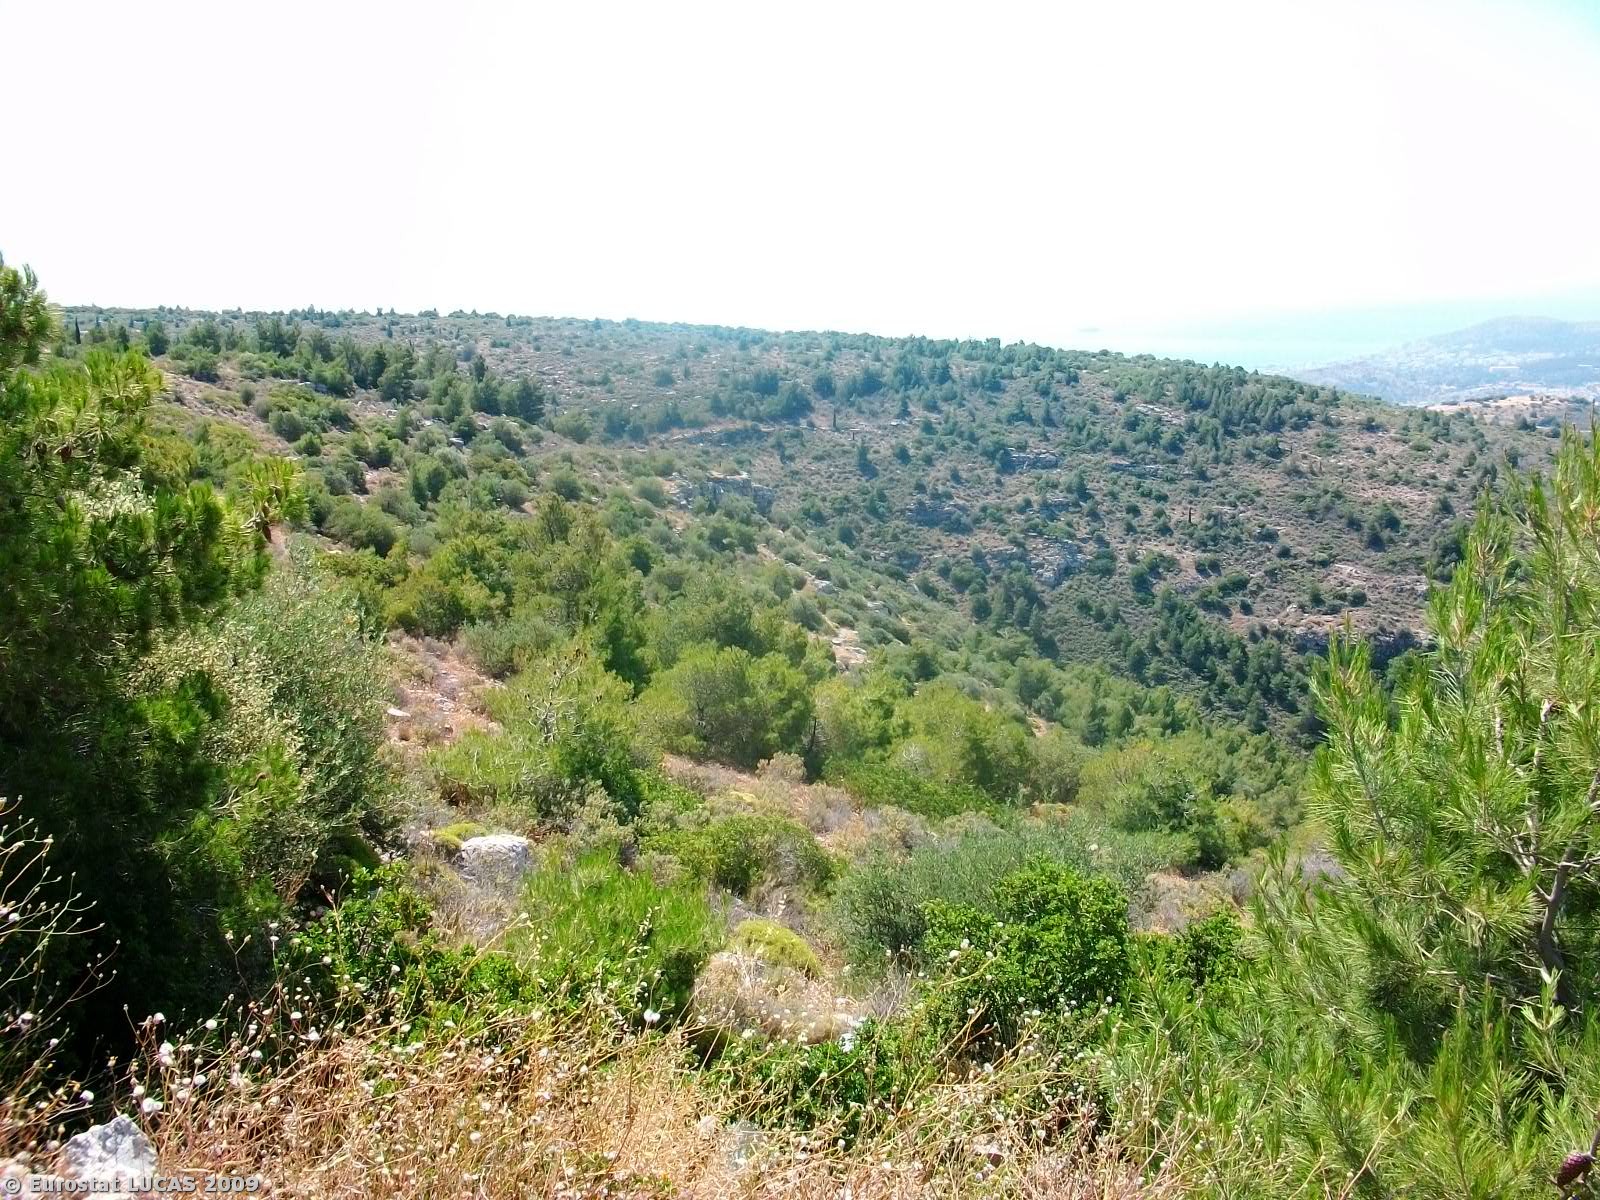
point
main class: Woodland
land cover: Coniferous woodland
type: coniferous forest of the mediterranean region
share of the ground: 50 - 75 %
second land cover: Grassland with sparse tree/shrub cover
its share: 10 - 25 %
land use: Forestry
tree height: > 5 m
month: May
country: GR
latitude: 37.8579
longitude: 23.7890
